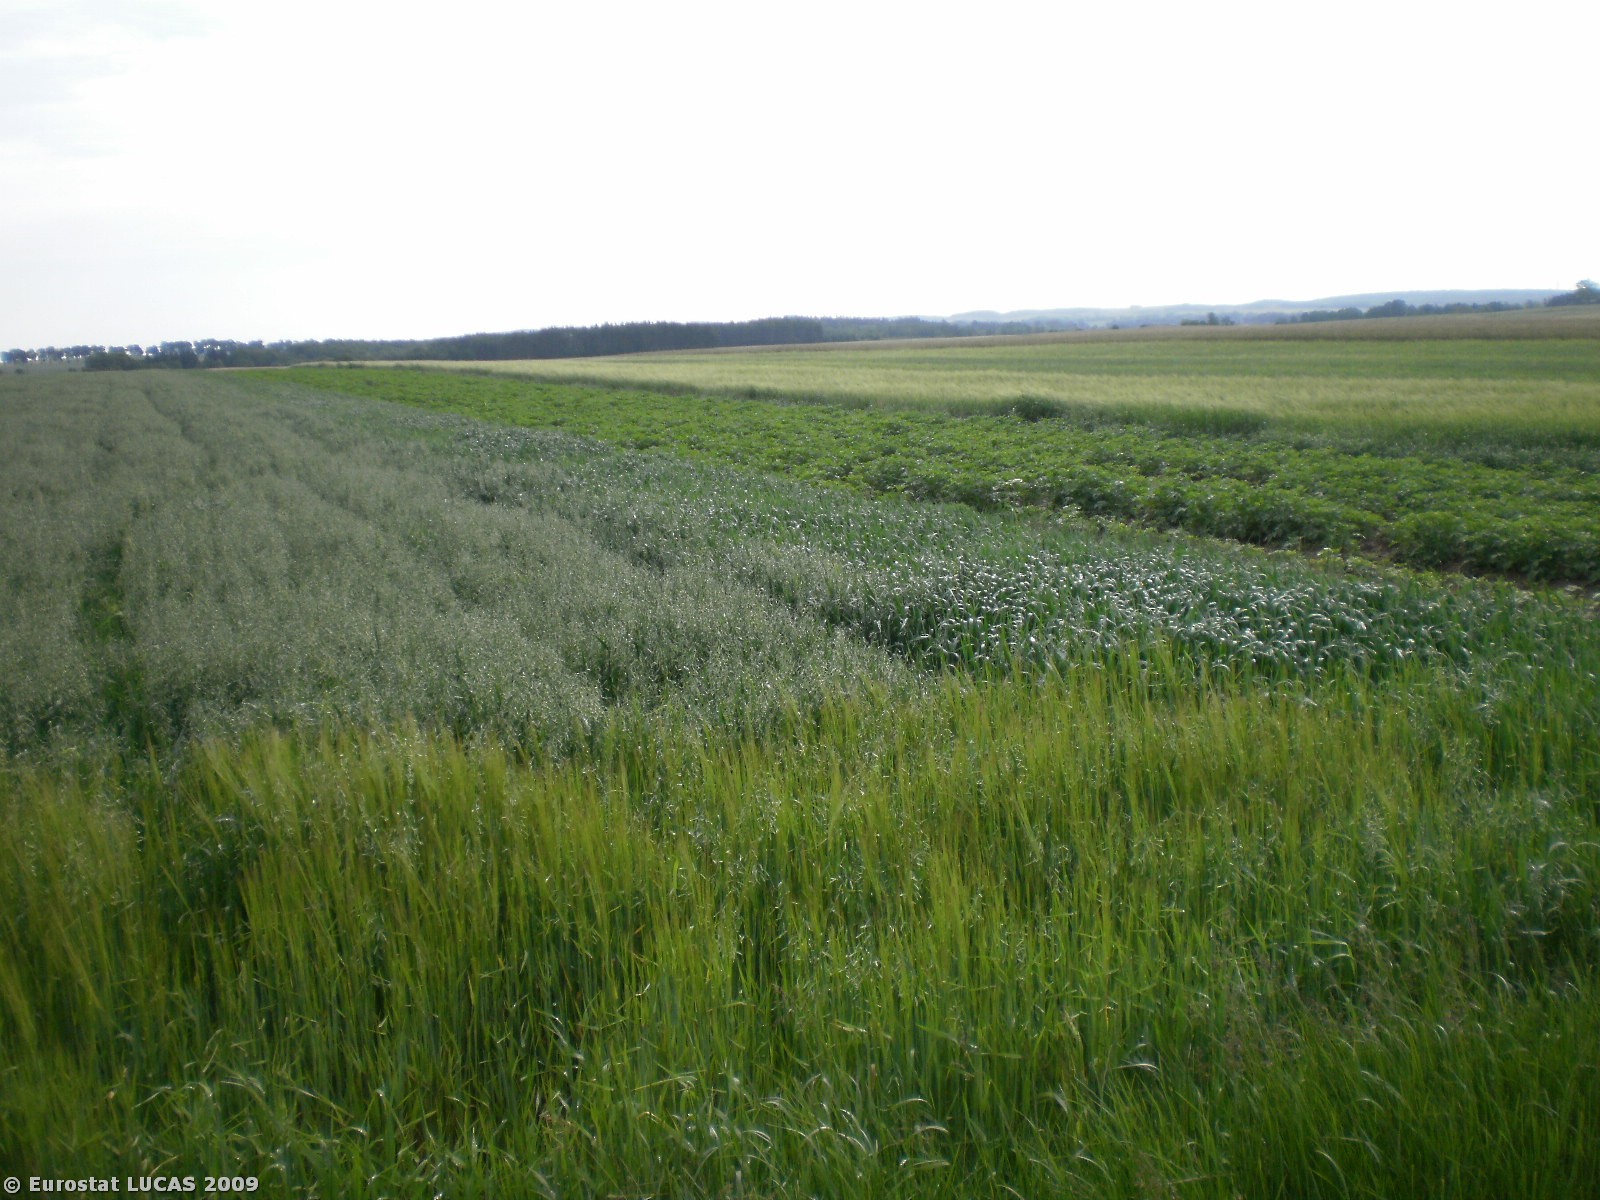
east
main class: Cropland
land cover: Barley
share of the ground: > 75 %
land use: Agriculture (excluding fallow land and kitchen gardens)
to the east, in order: Barley; Triticale; Mixed cereals for fodder; Triticale; Tracks; Triticale; Mixed cereals for fodder
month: June
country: PL
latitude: 53.5628
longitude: 19.8283
